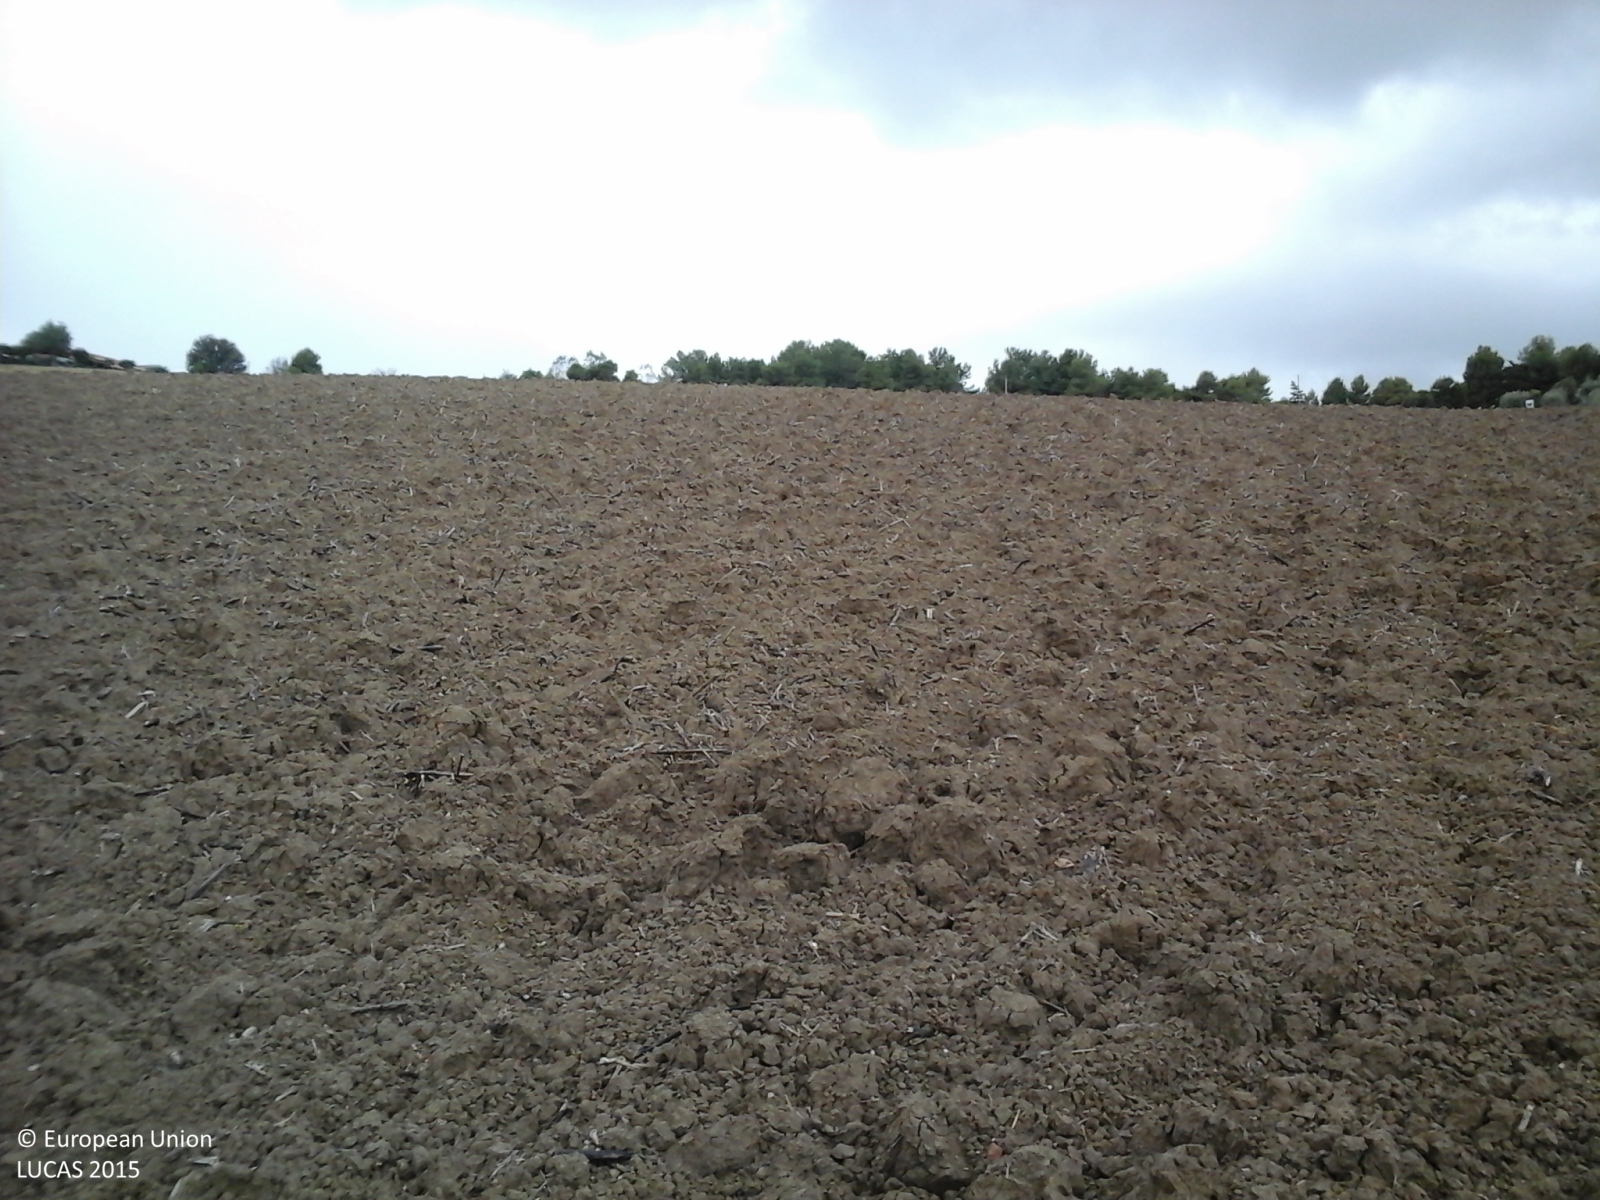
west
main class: Cropland
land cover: Sunflower
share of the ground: < 10 %
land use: Agriculture (excluding fallow land and kitchen gardens)
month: October
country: IT
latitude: 43.6865
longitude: 13.2302
